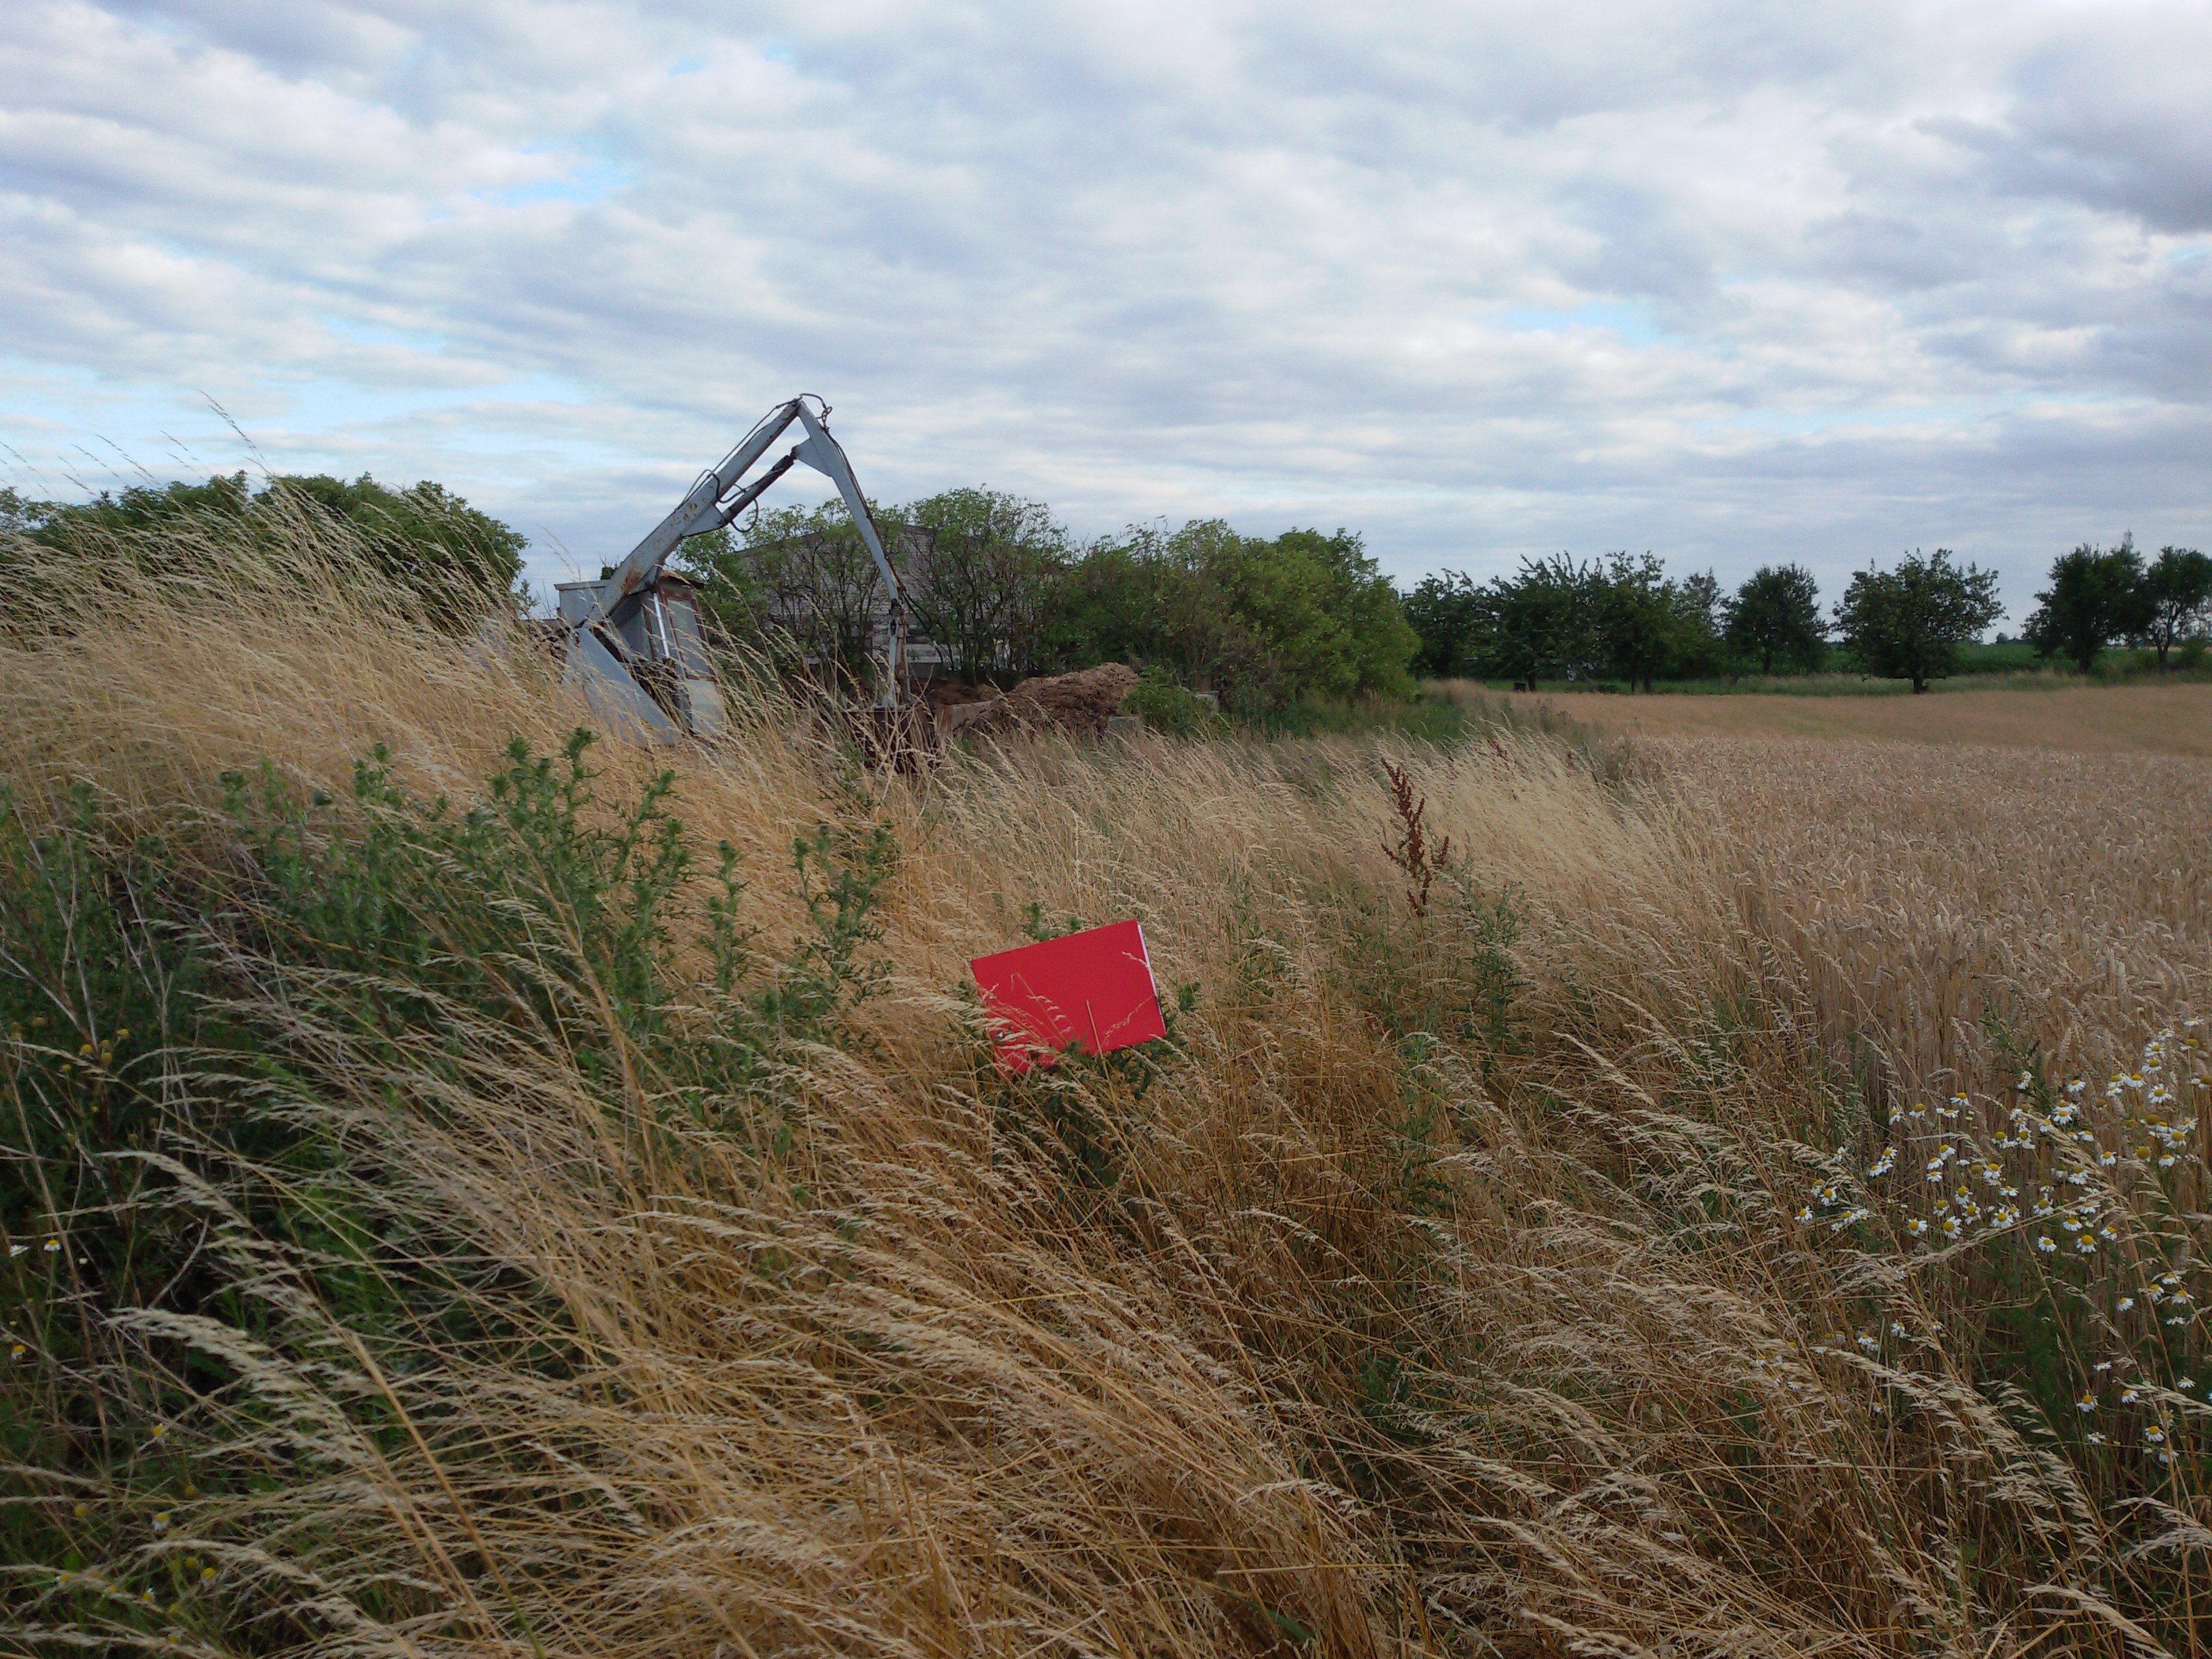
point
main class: Grassland
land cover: Spontaneously vegetated surfaces
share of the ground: > 75 %
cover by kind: herbaceous plants 100 %
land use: Logistics and storage
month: June
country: PL
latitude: 51.8949
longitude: 17.0874
